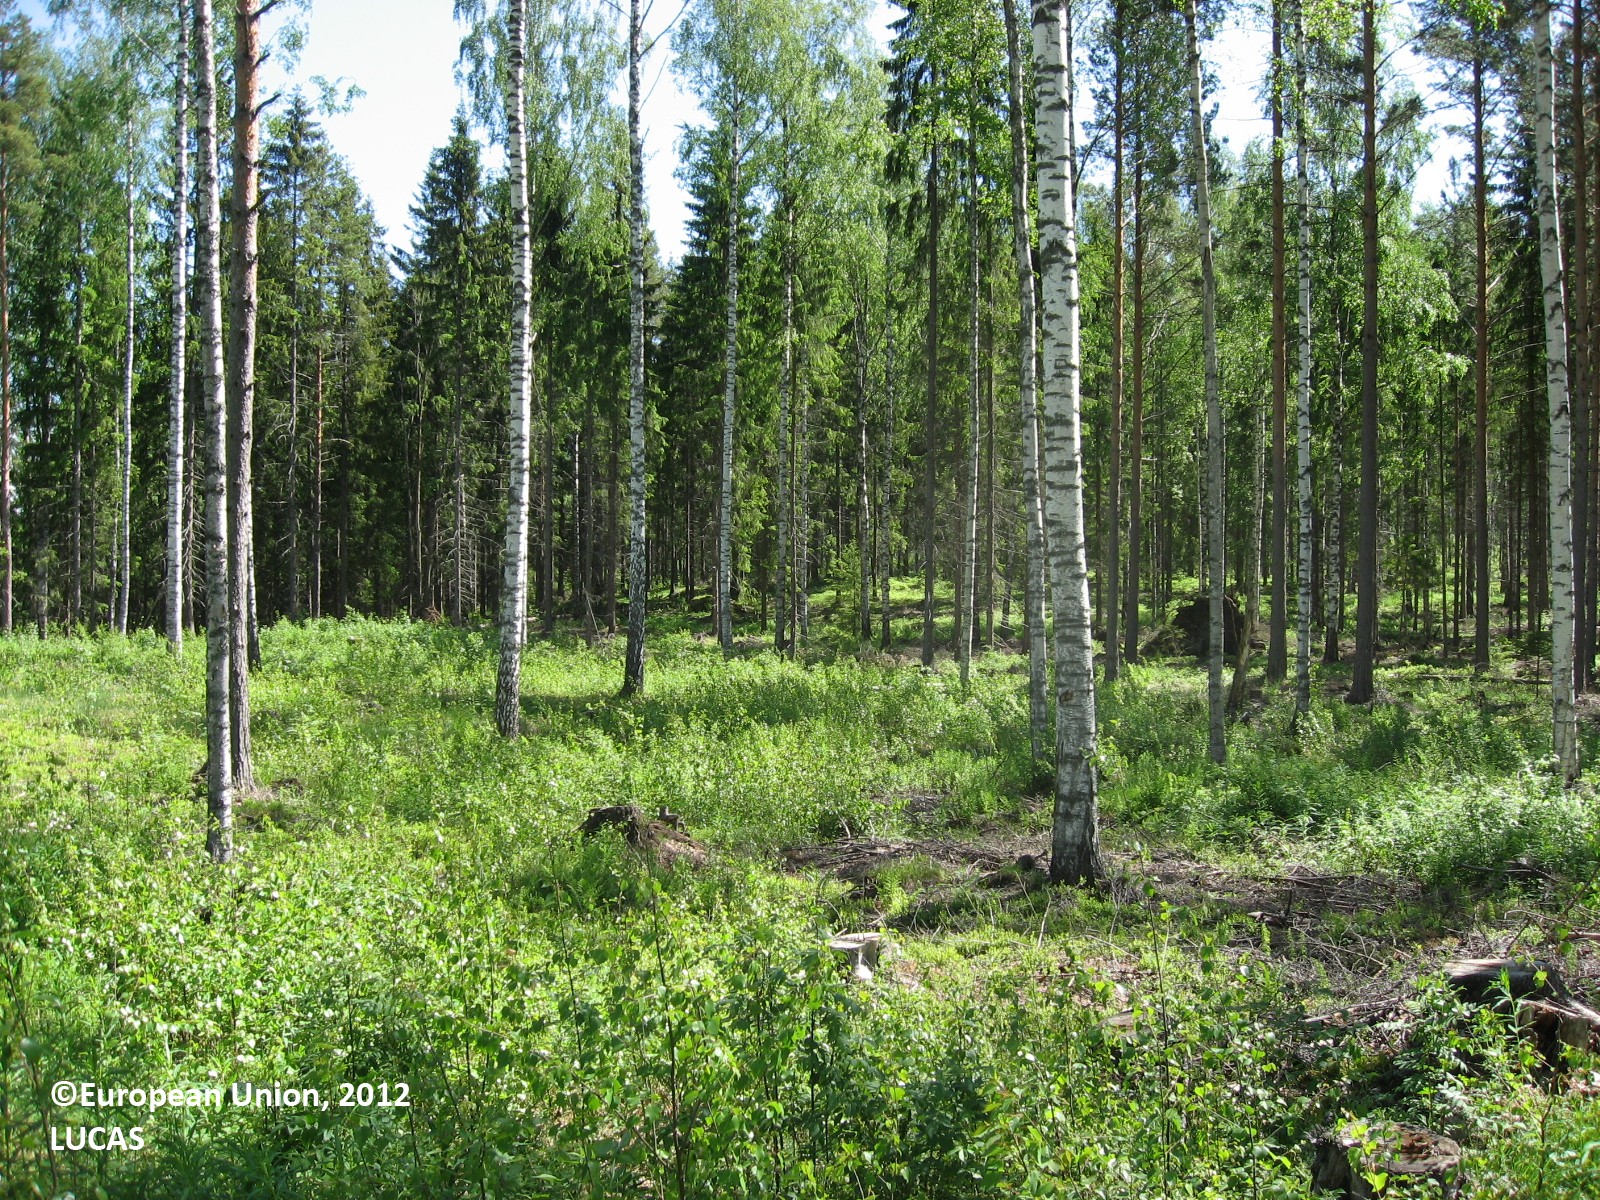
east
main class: Woodland
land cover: Pine dominated mixed woodland
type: boreal forest
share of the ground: 25 - 50 %
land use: Forestry
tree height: > 5 m
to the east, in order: Pine dominated mixed woodland; Ditches and canals; Spruce dominated mixed woodland
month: June
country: FI
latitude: 60.3742
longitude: 25.4163
